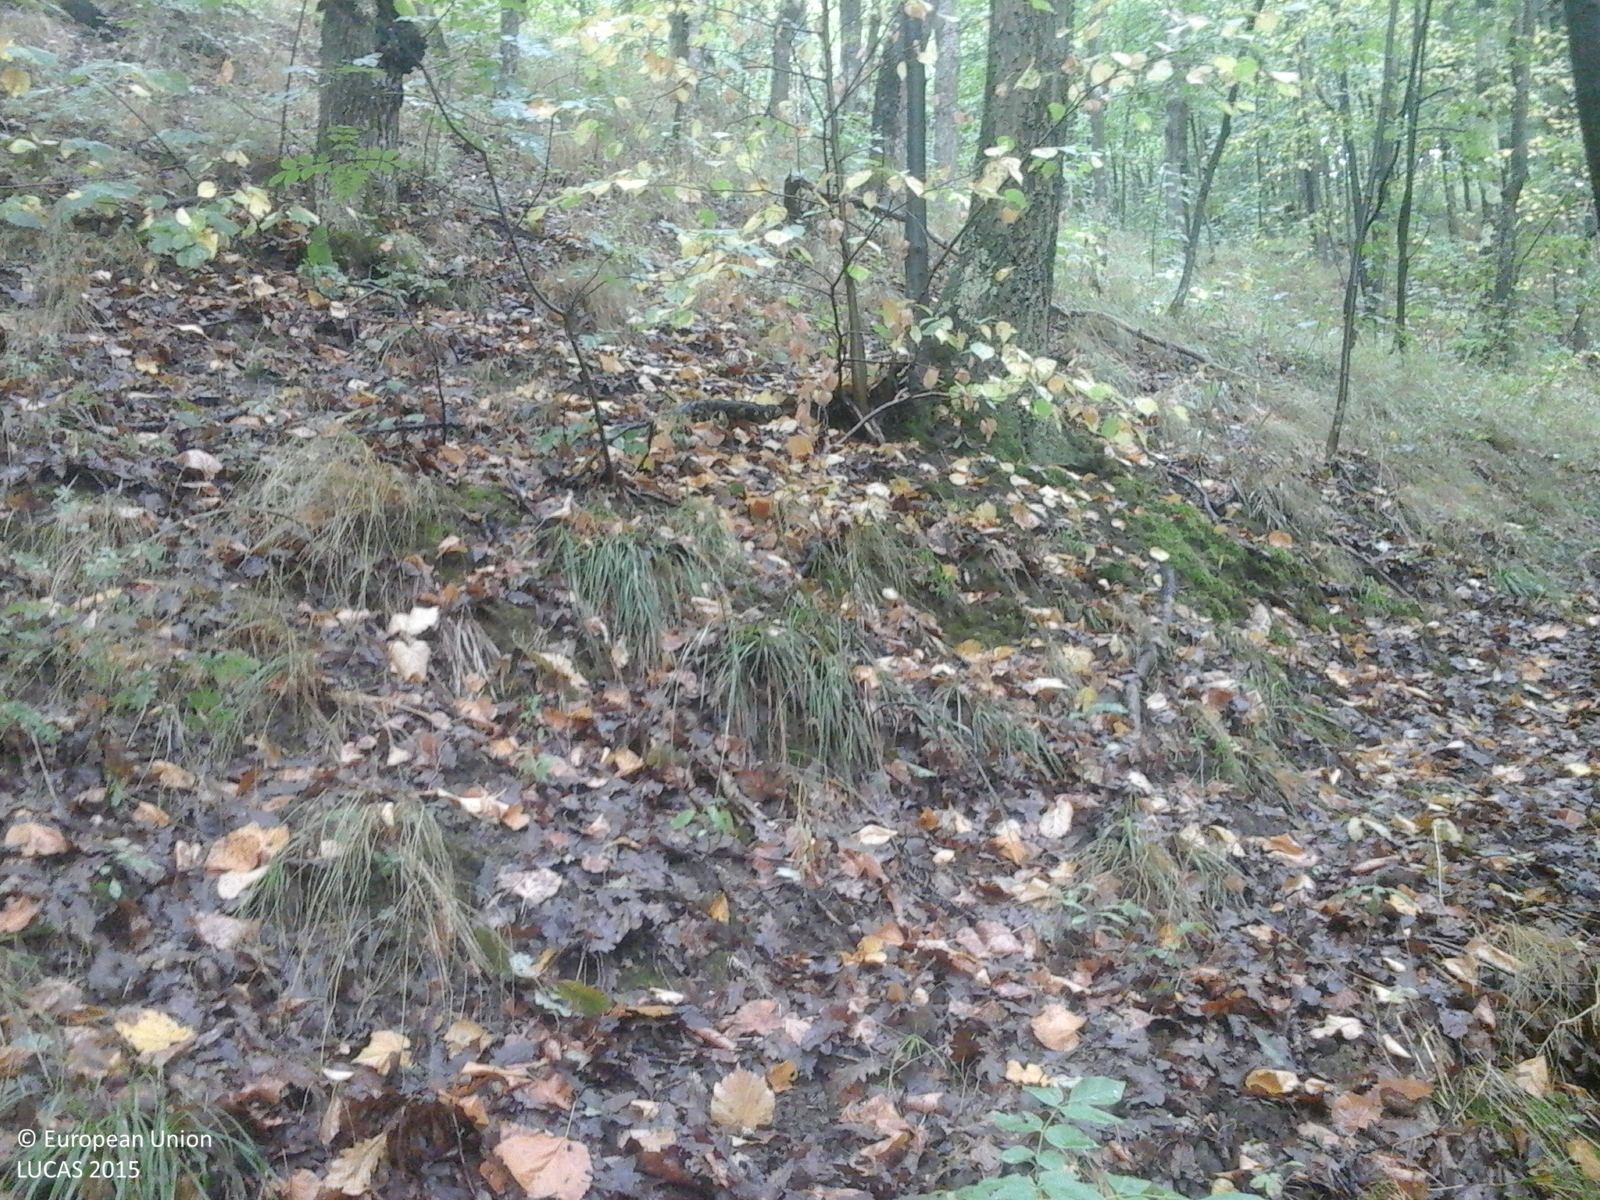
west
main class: Woodland
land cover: Broadleaved woodland
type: thermophilous deciduous forest
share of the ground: > 75 %
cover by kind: broadleaved forest trees 95 %, herbaceous plants 5 %
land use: Forestry
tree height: > 5 m
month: August
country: RO
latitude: 45.0088
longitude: 22.2313
